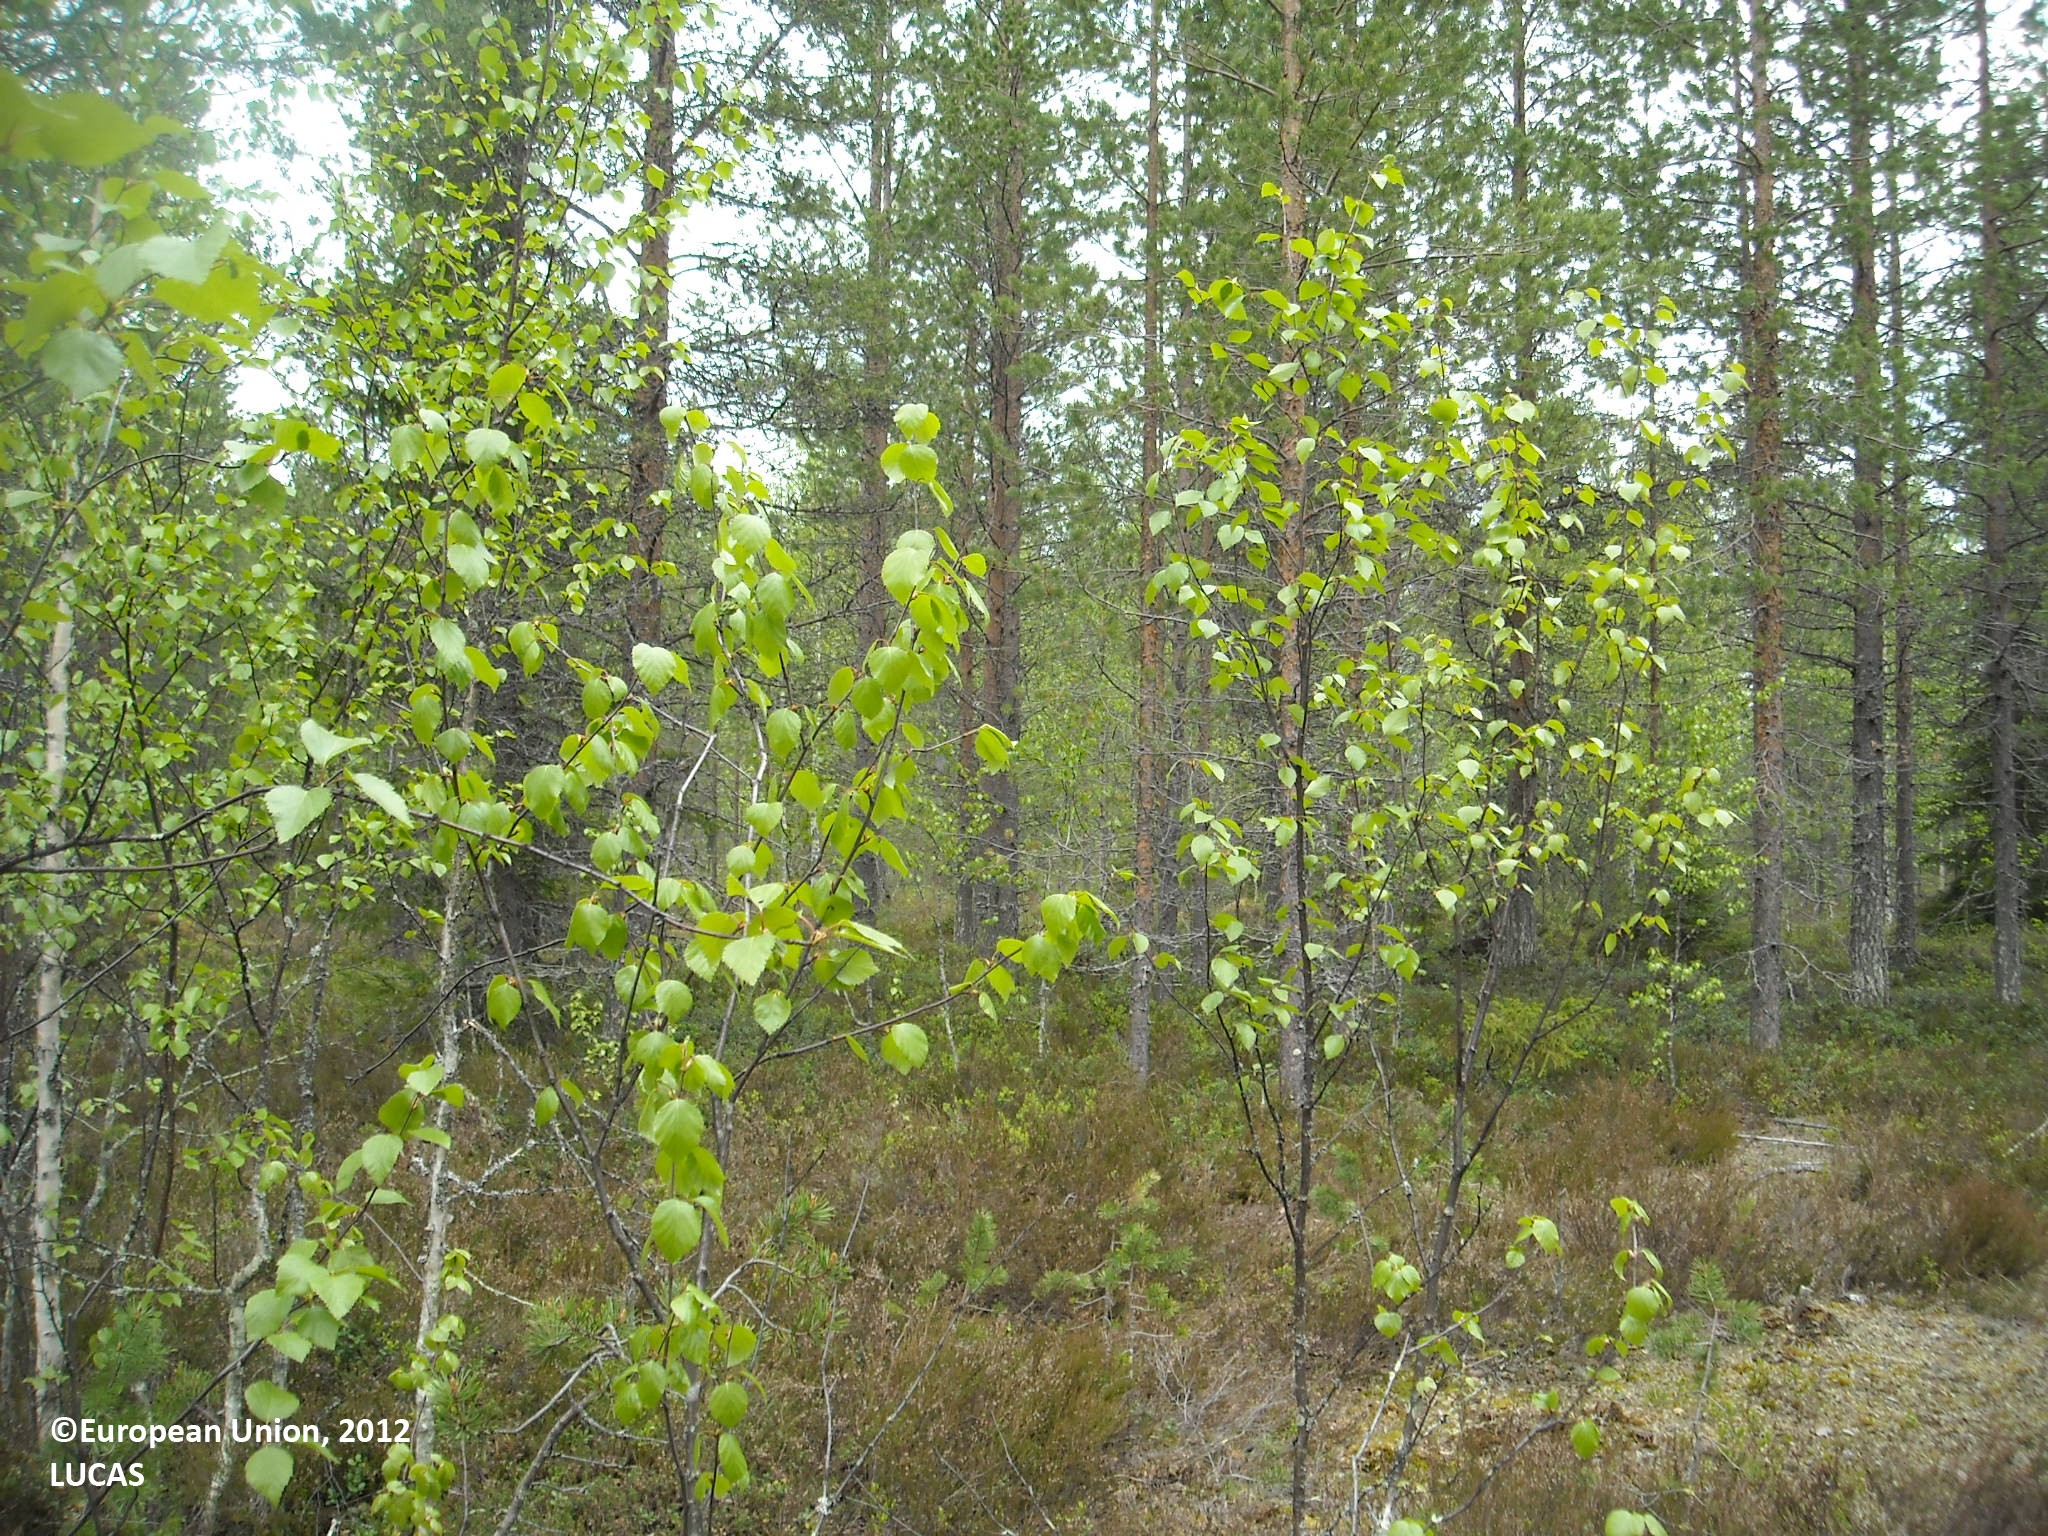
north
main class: Woodland
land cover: Pine dominated mixed woodland
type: boreal forest
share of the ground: > 75 %
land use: Forestry
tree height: > 5 m
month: June
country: FI
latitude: 65.2599
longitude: 27.8095
